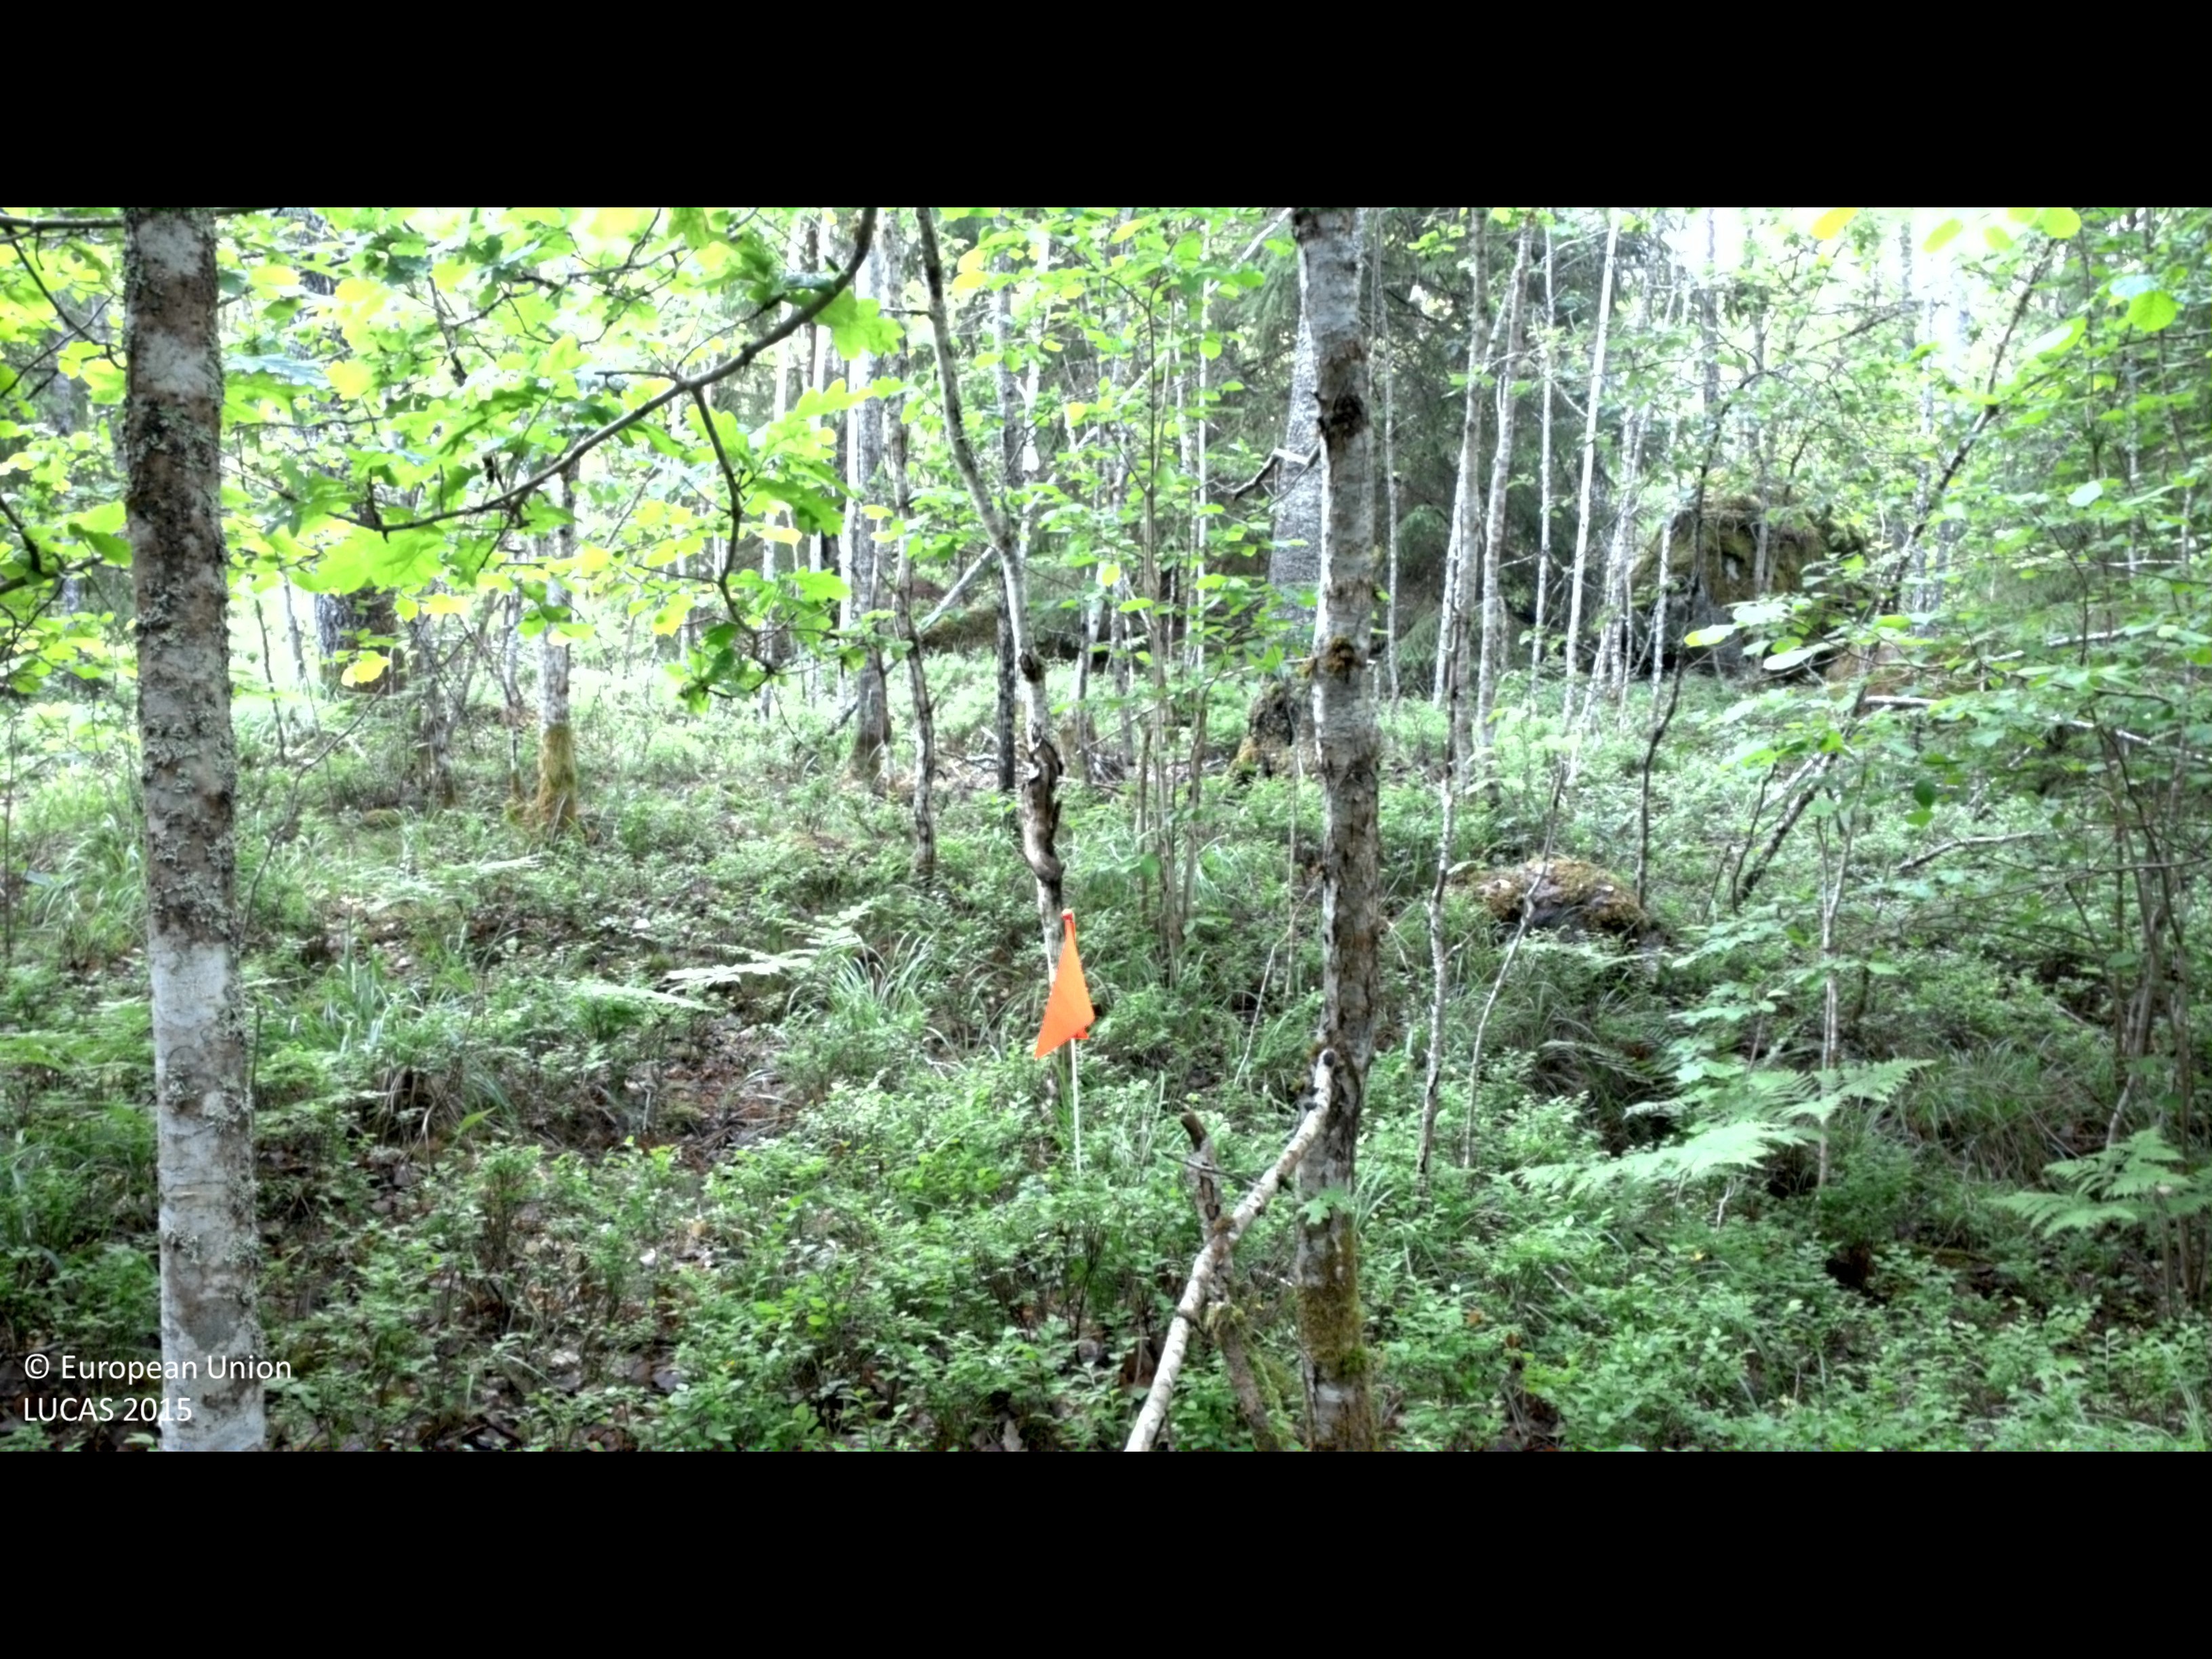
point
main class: Woodland
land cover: Broadleaved woodland
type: boreal forest
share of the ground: 50 - 75 %
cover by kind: broadleaved forest trees 60 %, coniferous forest trees 15 %, shrubs 15 %, herbaceous plants 5 %, lichens and mosses 5 %
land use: Forestry
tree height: > 5 m
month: June
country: SE
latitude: 58.0265
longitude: 16.1090
